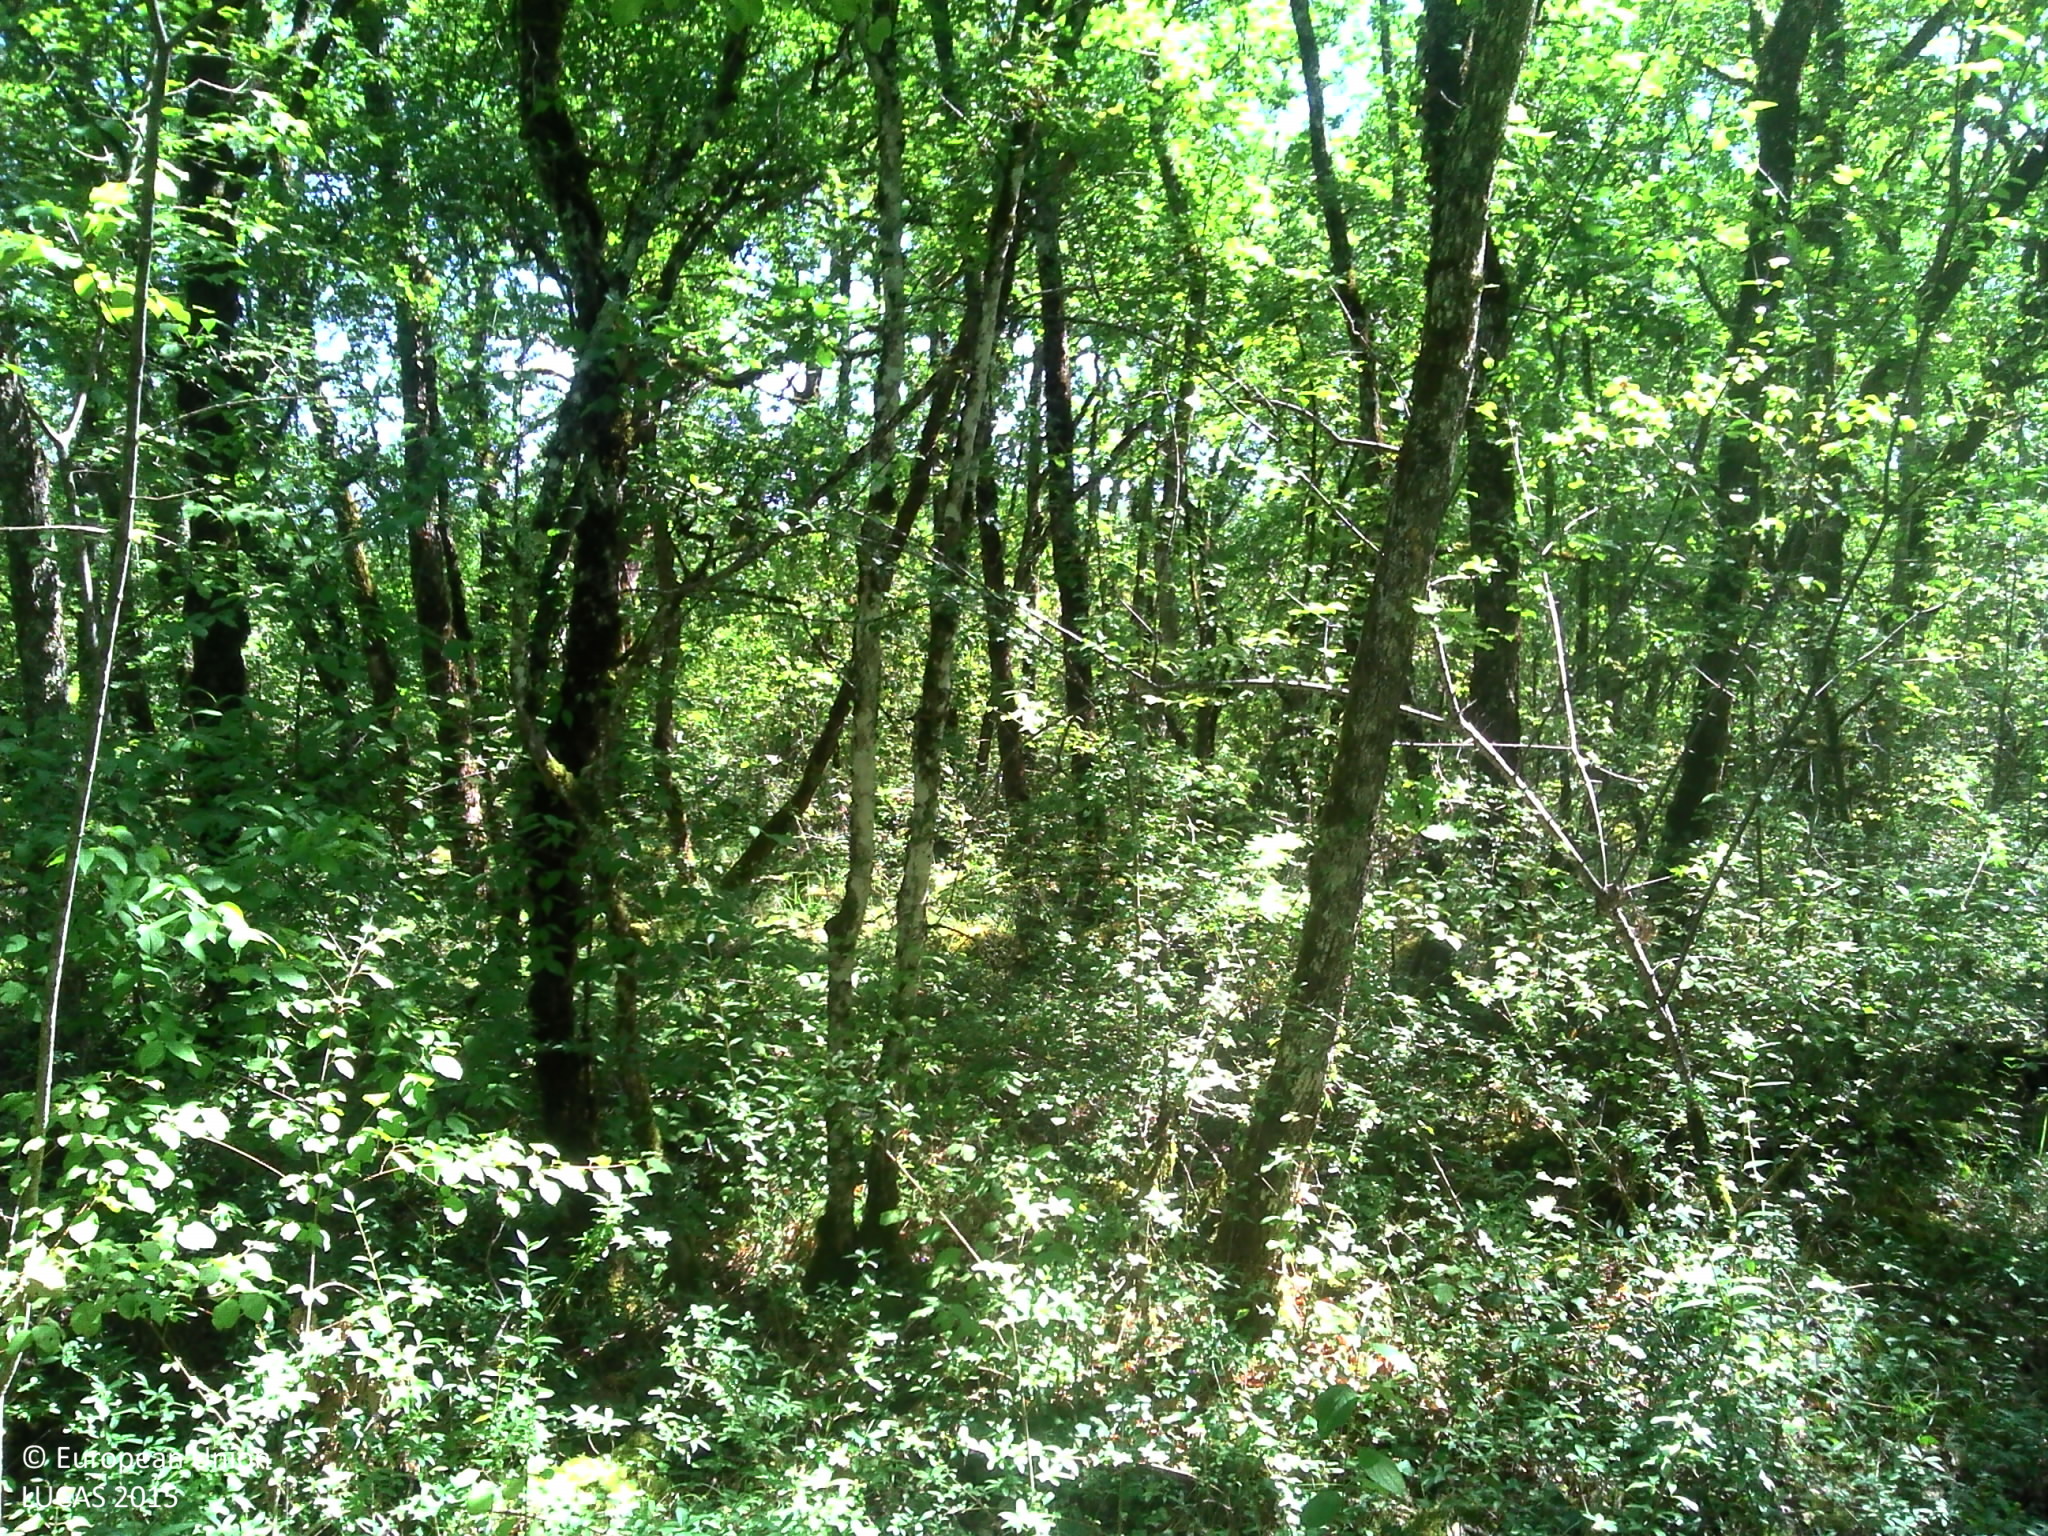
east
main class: Woodland
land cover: Broadleaved woodland
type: thermophilous deciduous forest
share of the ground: > 75 %
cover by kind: broadleaved forest trees 60 %, shrubs 25 %, herbaceous plants 10 %, lichens and mosses 5 %
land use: Forestry
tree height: > 5 m
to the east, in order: Broadleaved woodland; Dry stone walls; Shrubland with sparse tree cover; Dry stone walls; Broadleaved woodland; Dry stone walls; Broadleaved woodland
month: August
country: FR
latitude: 44.2848
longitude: 1.6418
